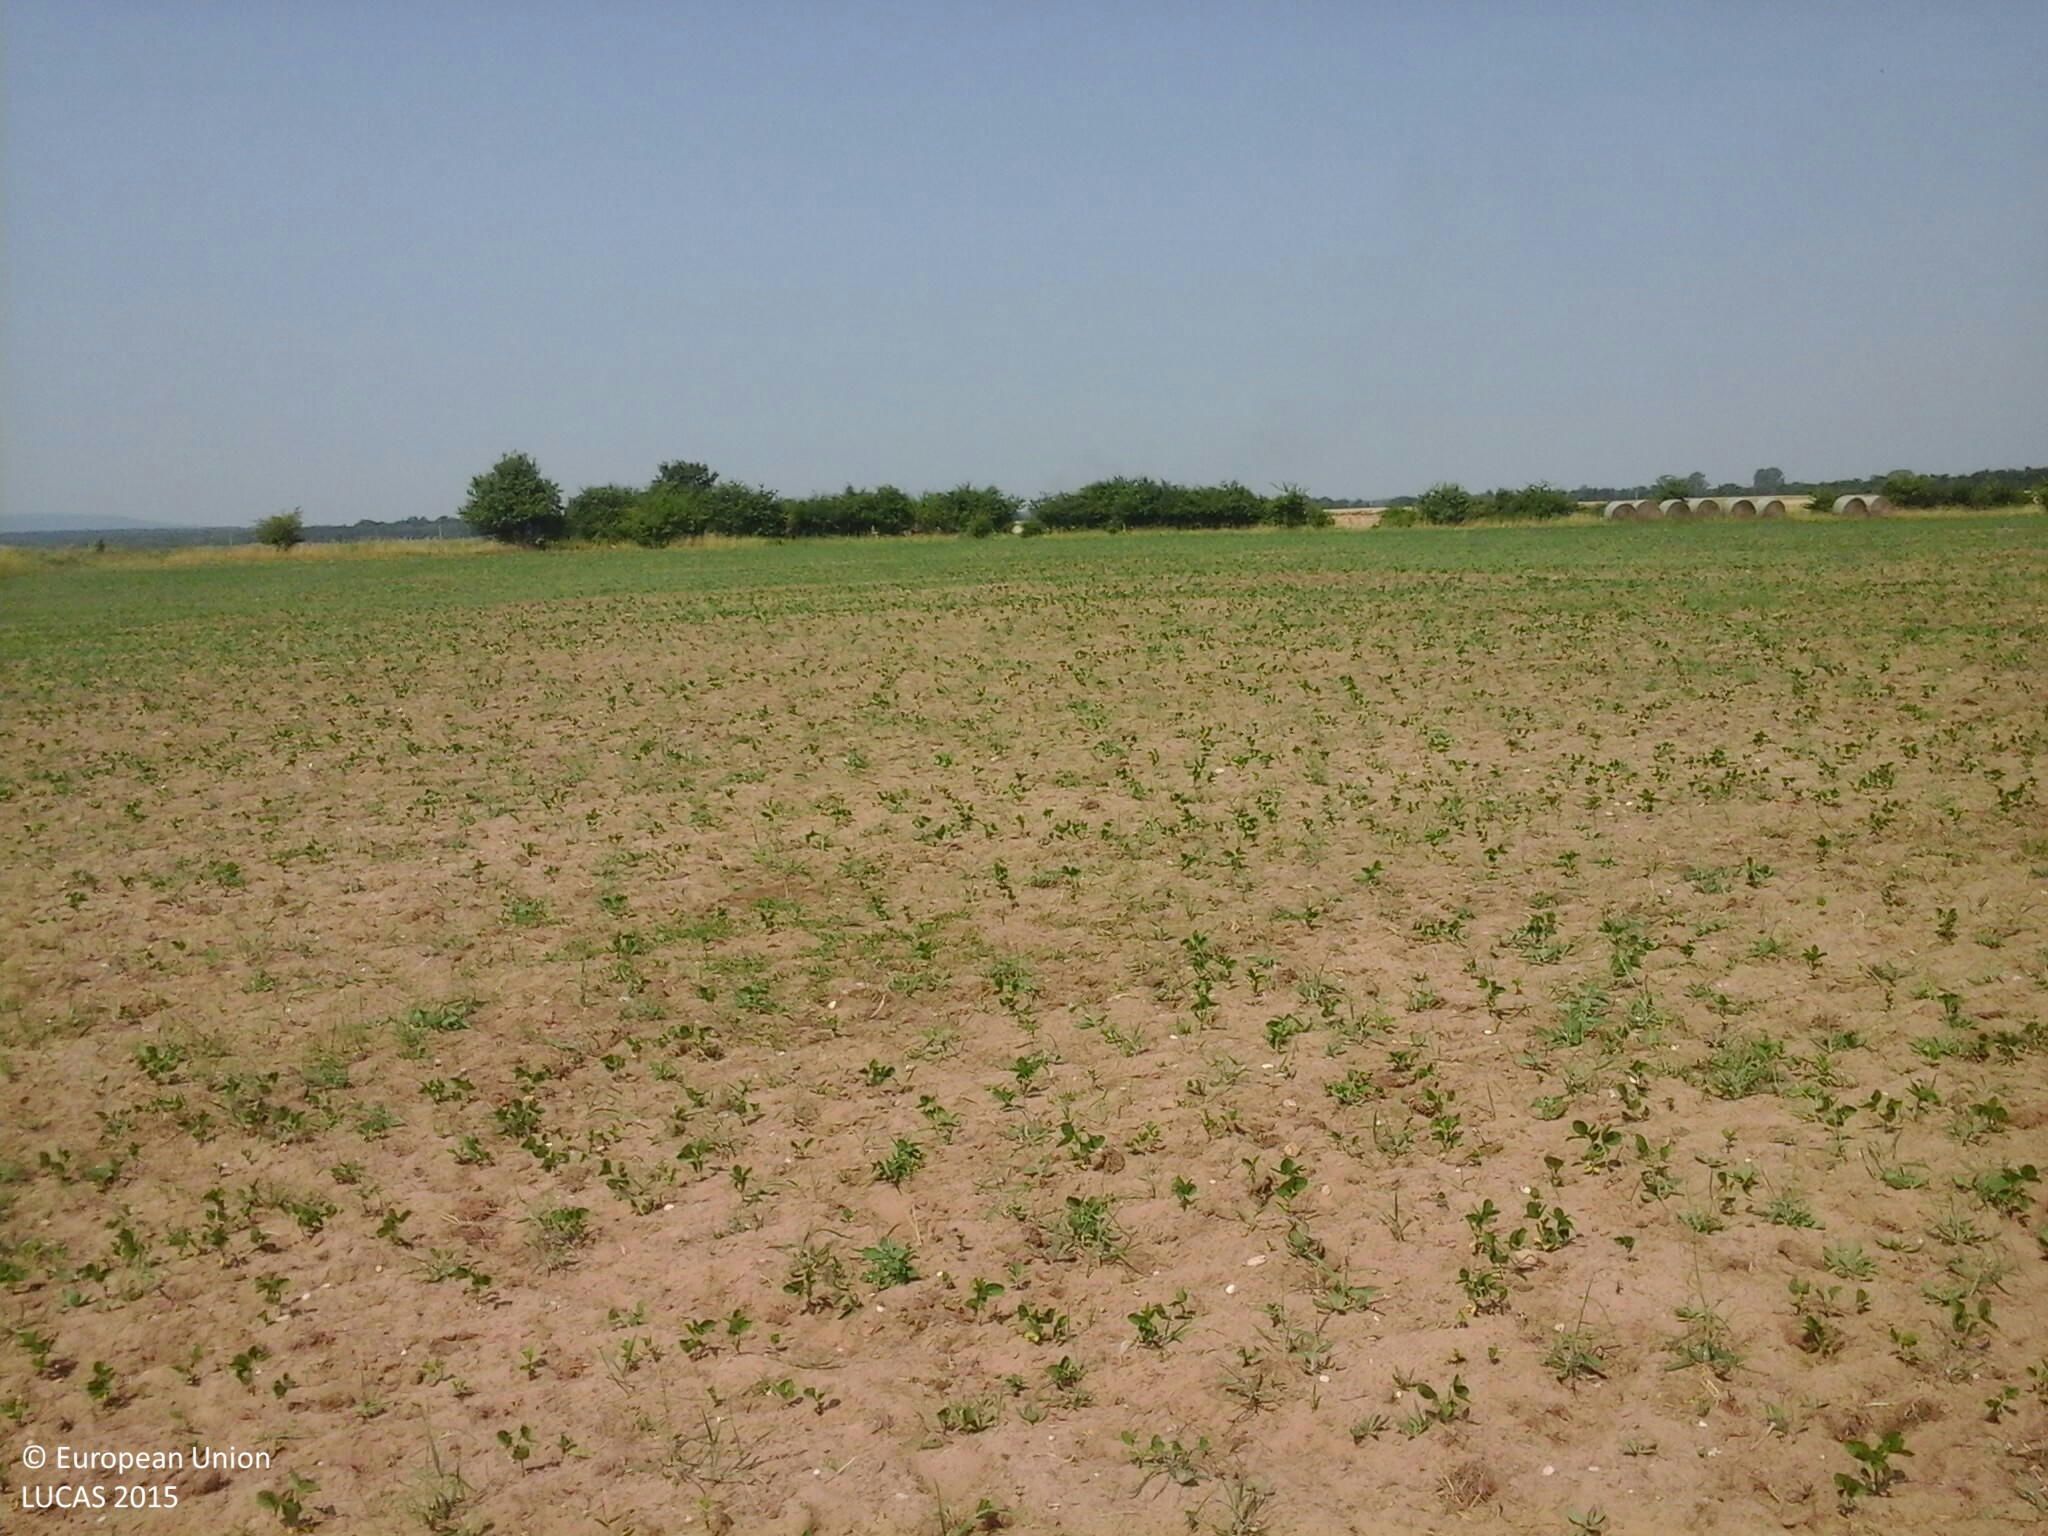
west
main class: Cropland
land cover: Soya
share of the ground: 10 - 25 %
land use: Agriculture (excluding fallow land and kitchen gardens)
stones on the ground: < 10 %
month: July
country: HU
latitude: 47.0481
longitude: 17.4699
